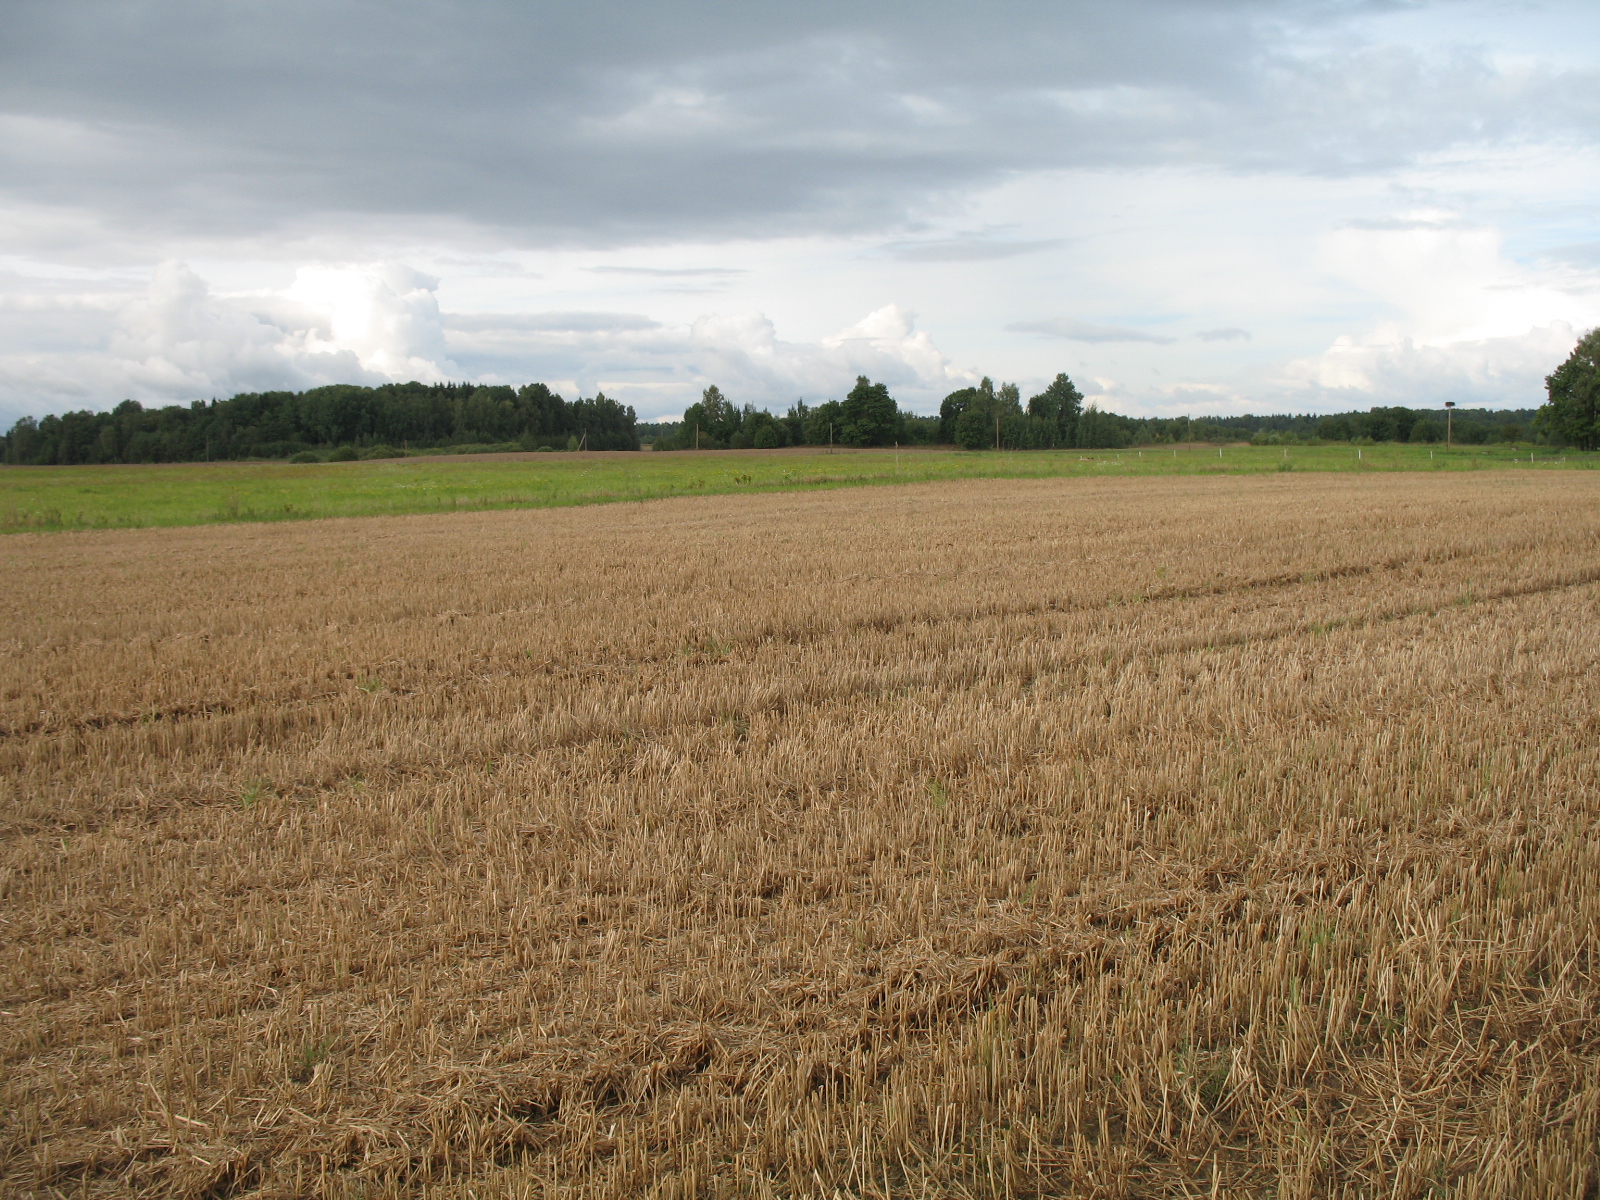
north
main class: Cropland
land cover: Common wheat
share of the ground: < 10 %
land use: Agriculture (excluding fallow land and kitchen gardens)
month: September
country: LV
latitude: 56.0872
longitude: 25.8983
